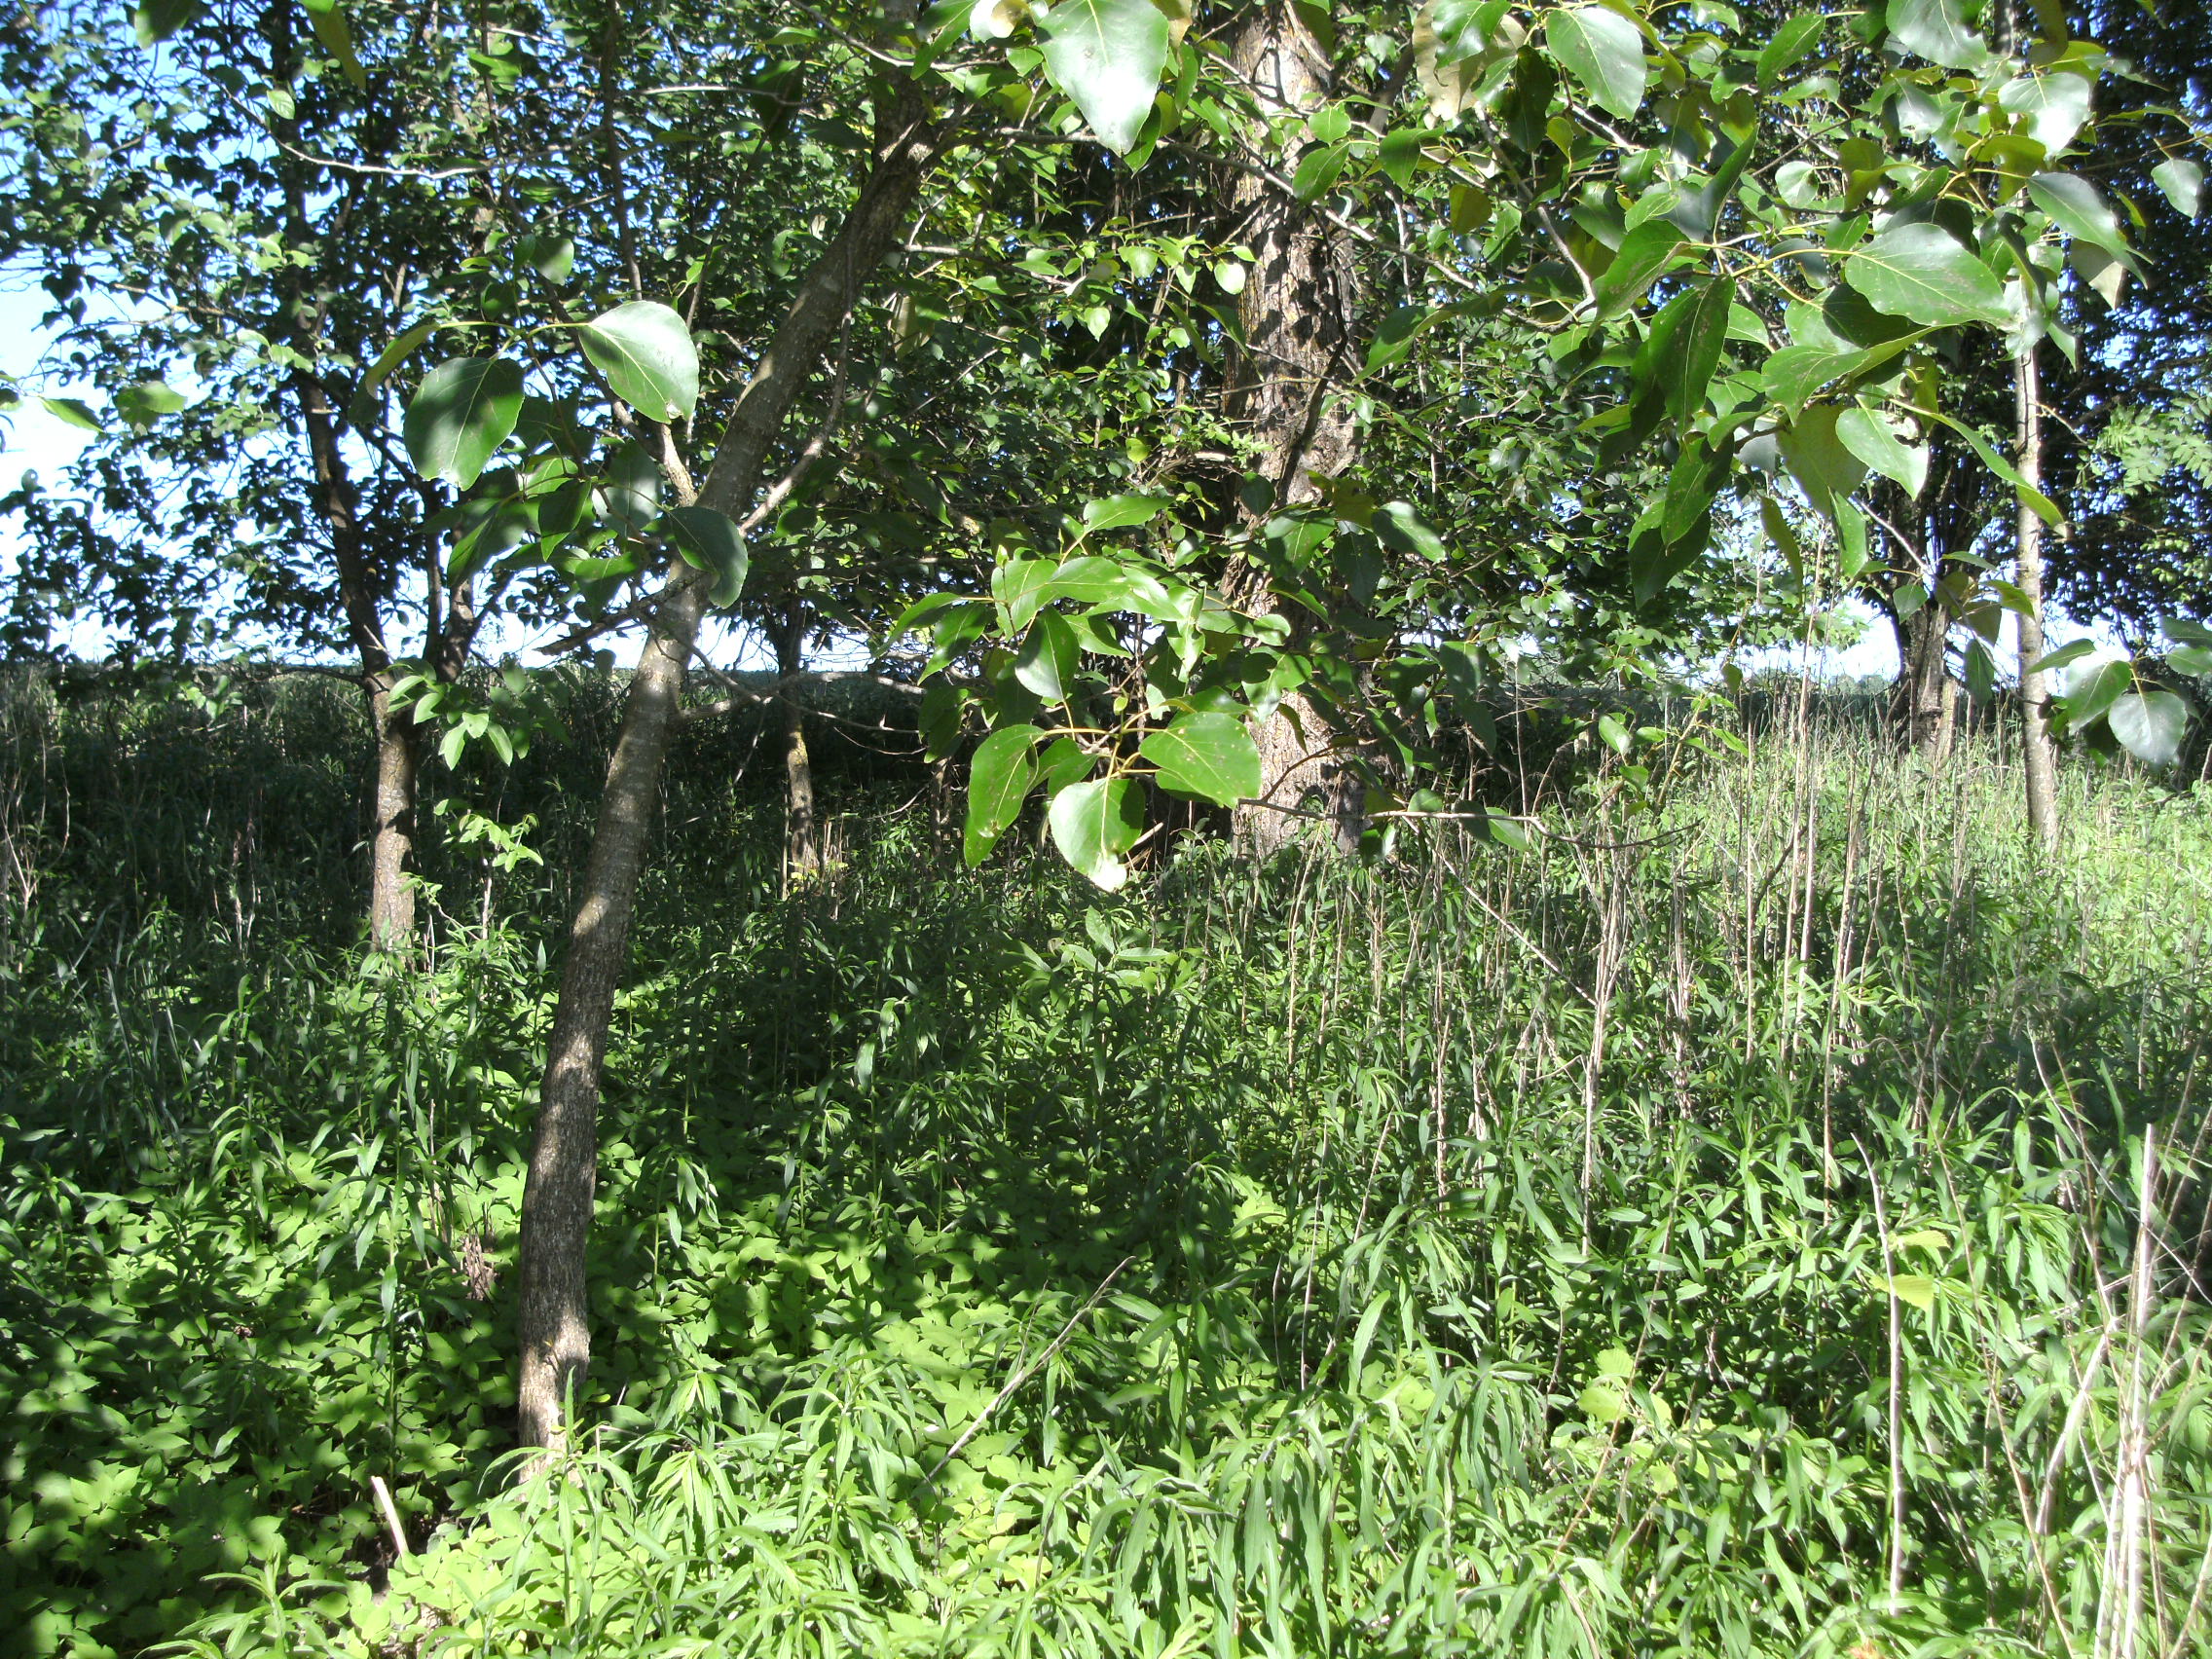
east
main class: Woodland
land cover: Broadleaved woodland
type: mesophytic deciduous forest
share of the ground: > 75 %
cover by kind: broadleaved forest trees 80 %, herbaceous plants 20 %
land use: Semi-natural and natural areas not in use
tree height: > 5 m
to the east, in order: Broadleaved woodland; Soya; Grass margins; Tracks; Grass margins; Common wheat
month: May
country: AT
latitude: 48.3070
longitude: 14.1661
